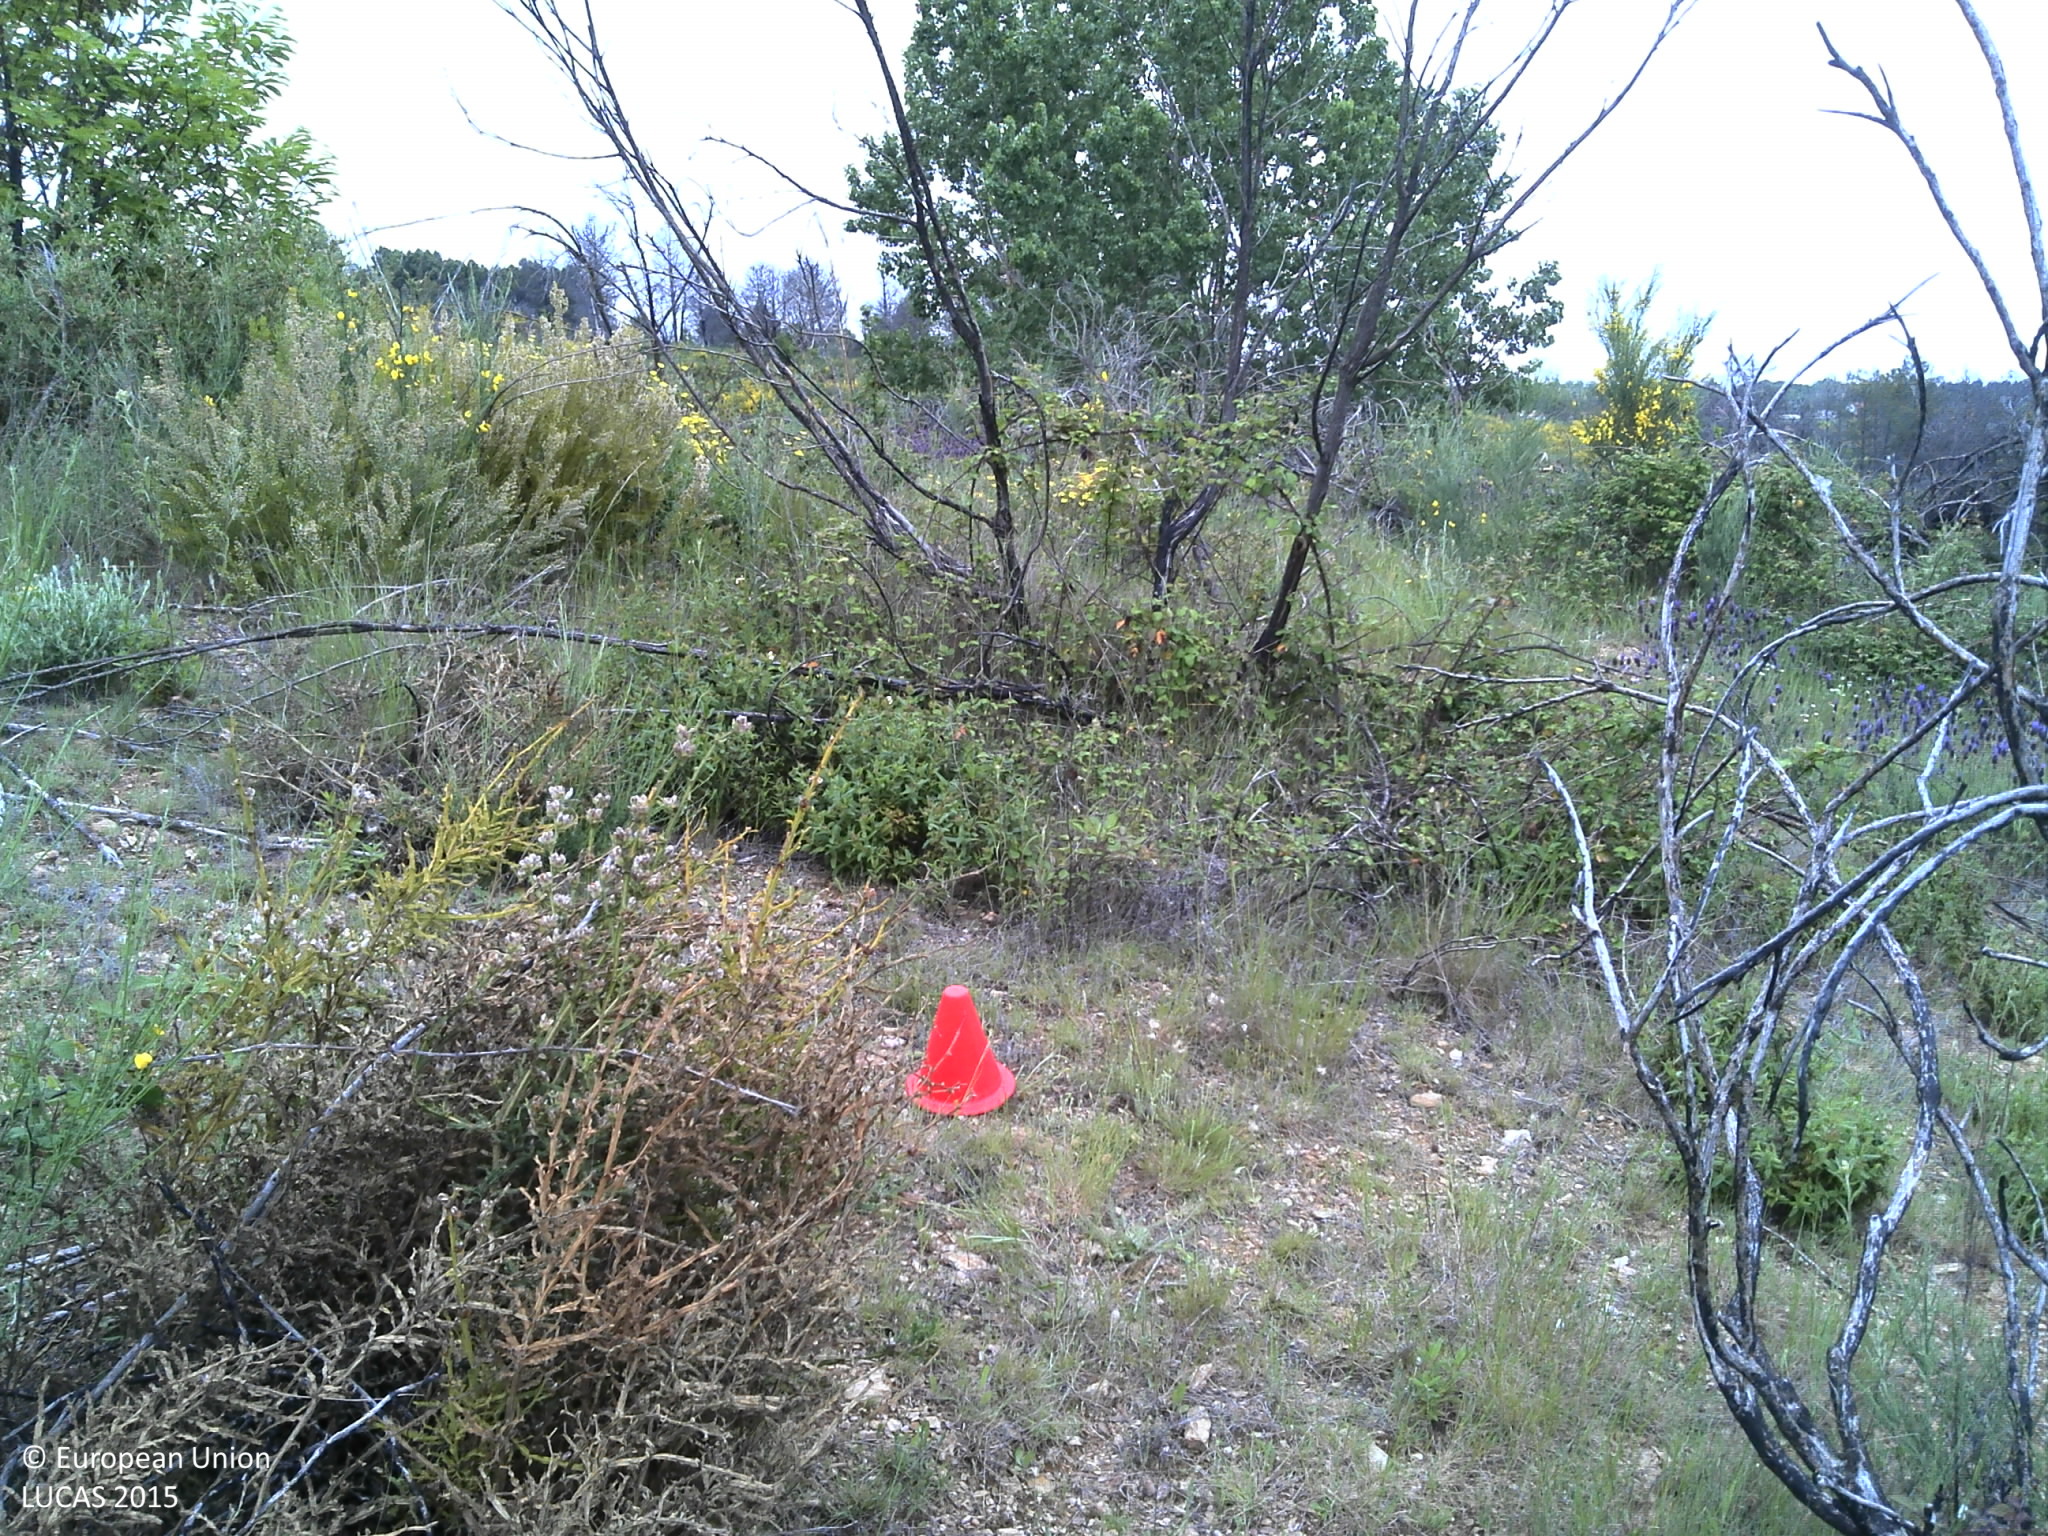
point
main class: Shrubland
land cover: Shrubland with sparse tree cover
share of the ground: 25 - 50 %
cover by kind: shrubs 50 %, unconsolidated bare surface 40 %, broadleaved forest trees 5 %, herbaceous plants 5 %
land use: Forestry
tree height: < 5 m
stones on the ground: 10 - 25 %
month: May
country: PT
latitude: 41.7947
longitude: -7.1017
